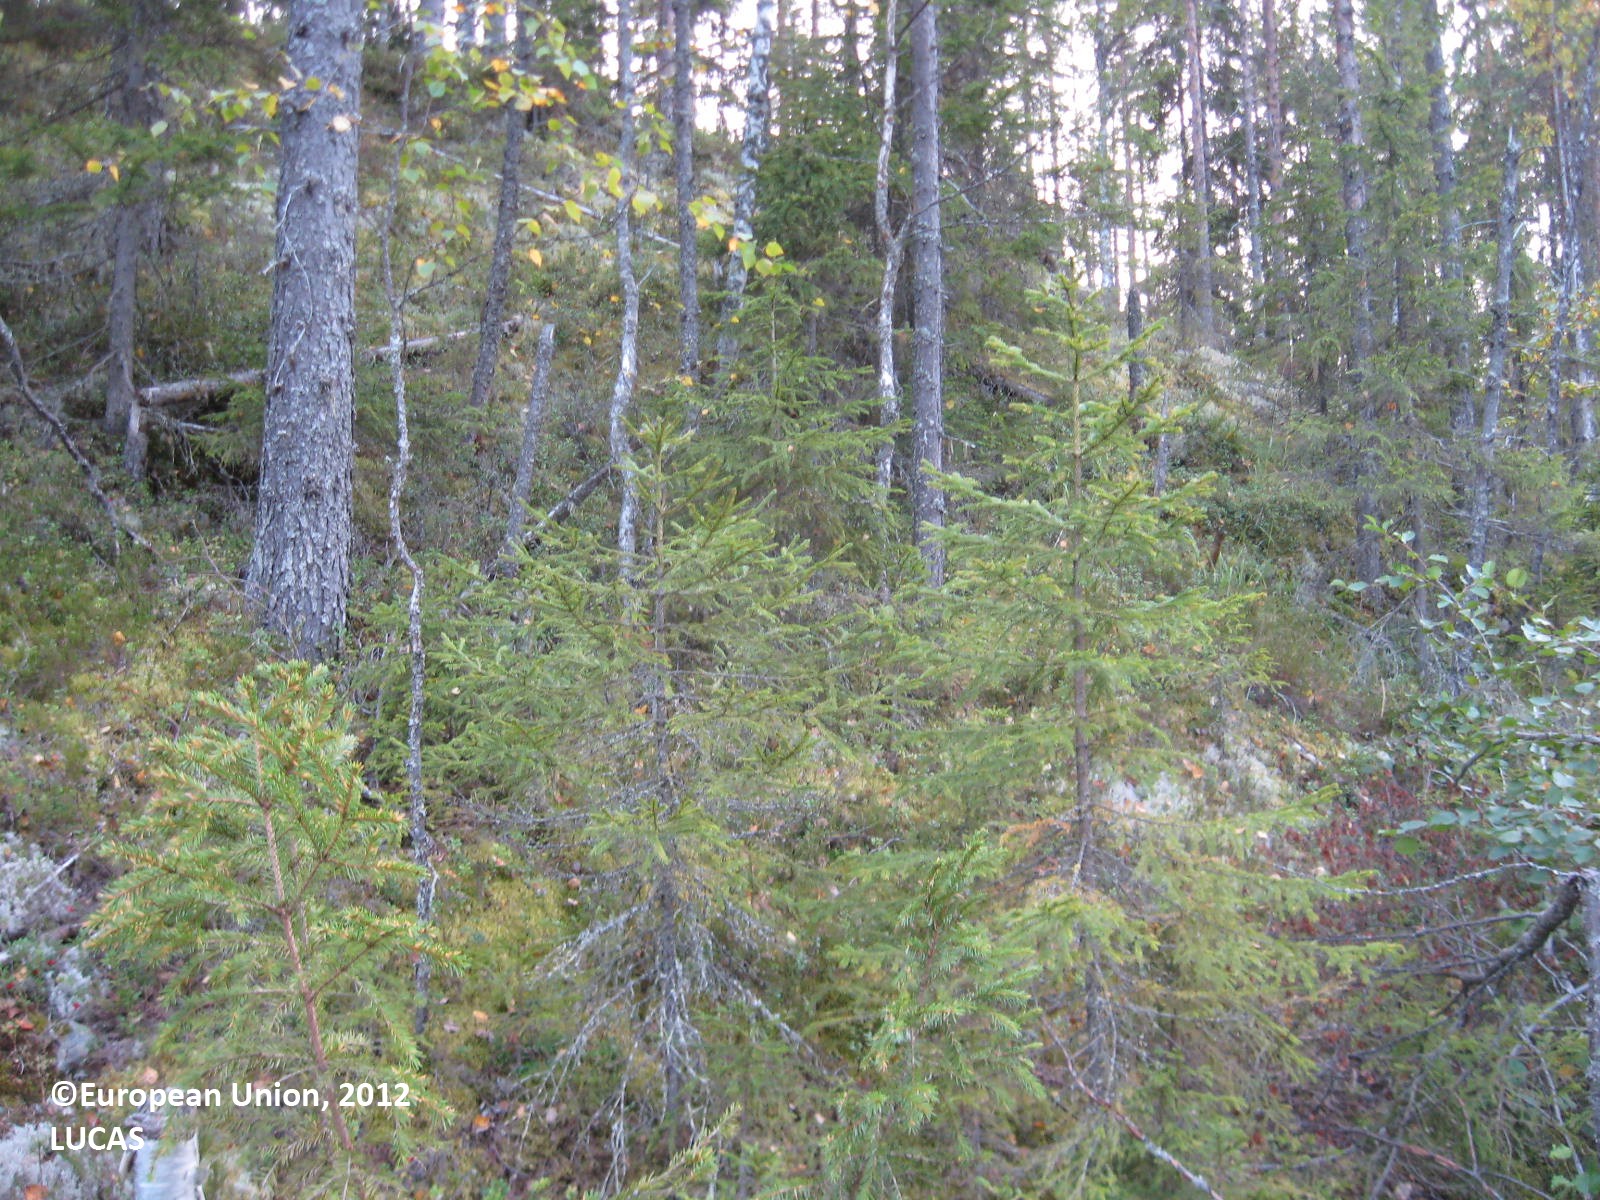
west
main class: Woodland
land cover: Other mixed woodland
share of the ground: > 75 %
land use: Forestry
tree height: < 5 m
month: August
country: FI
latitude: 63.9363
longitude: 28.4390
